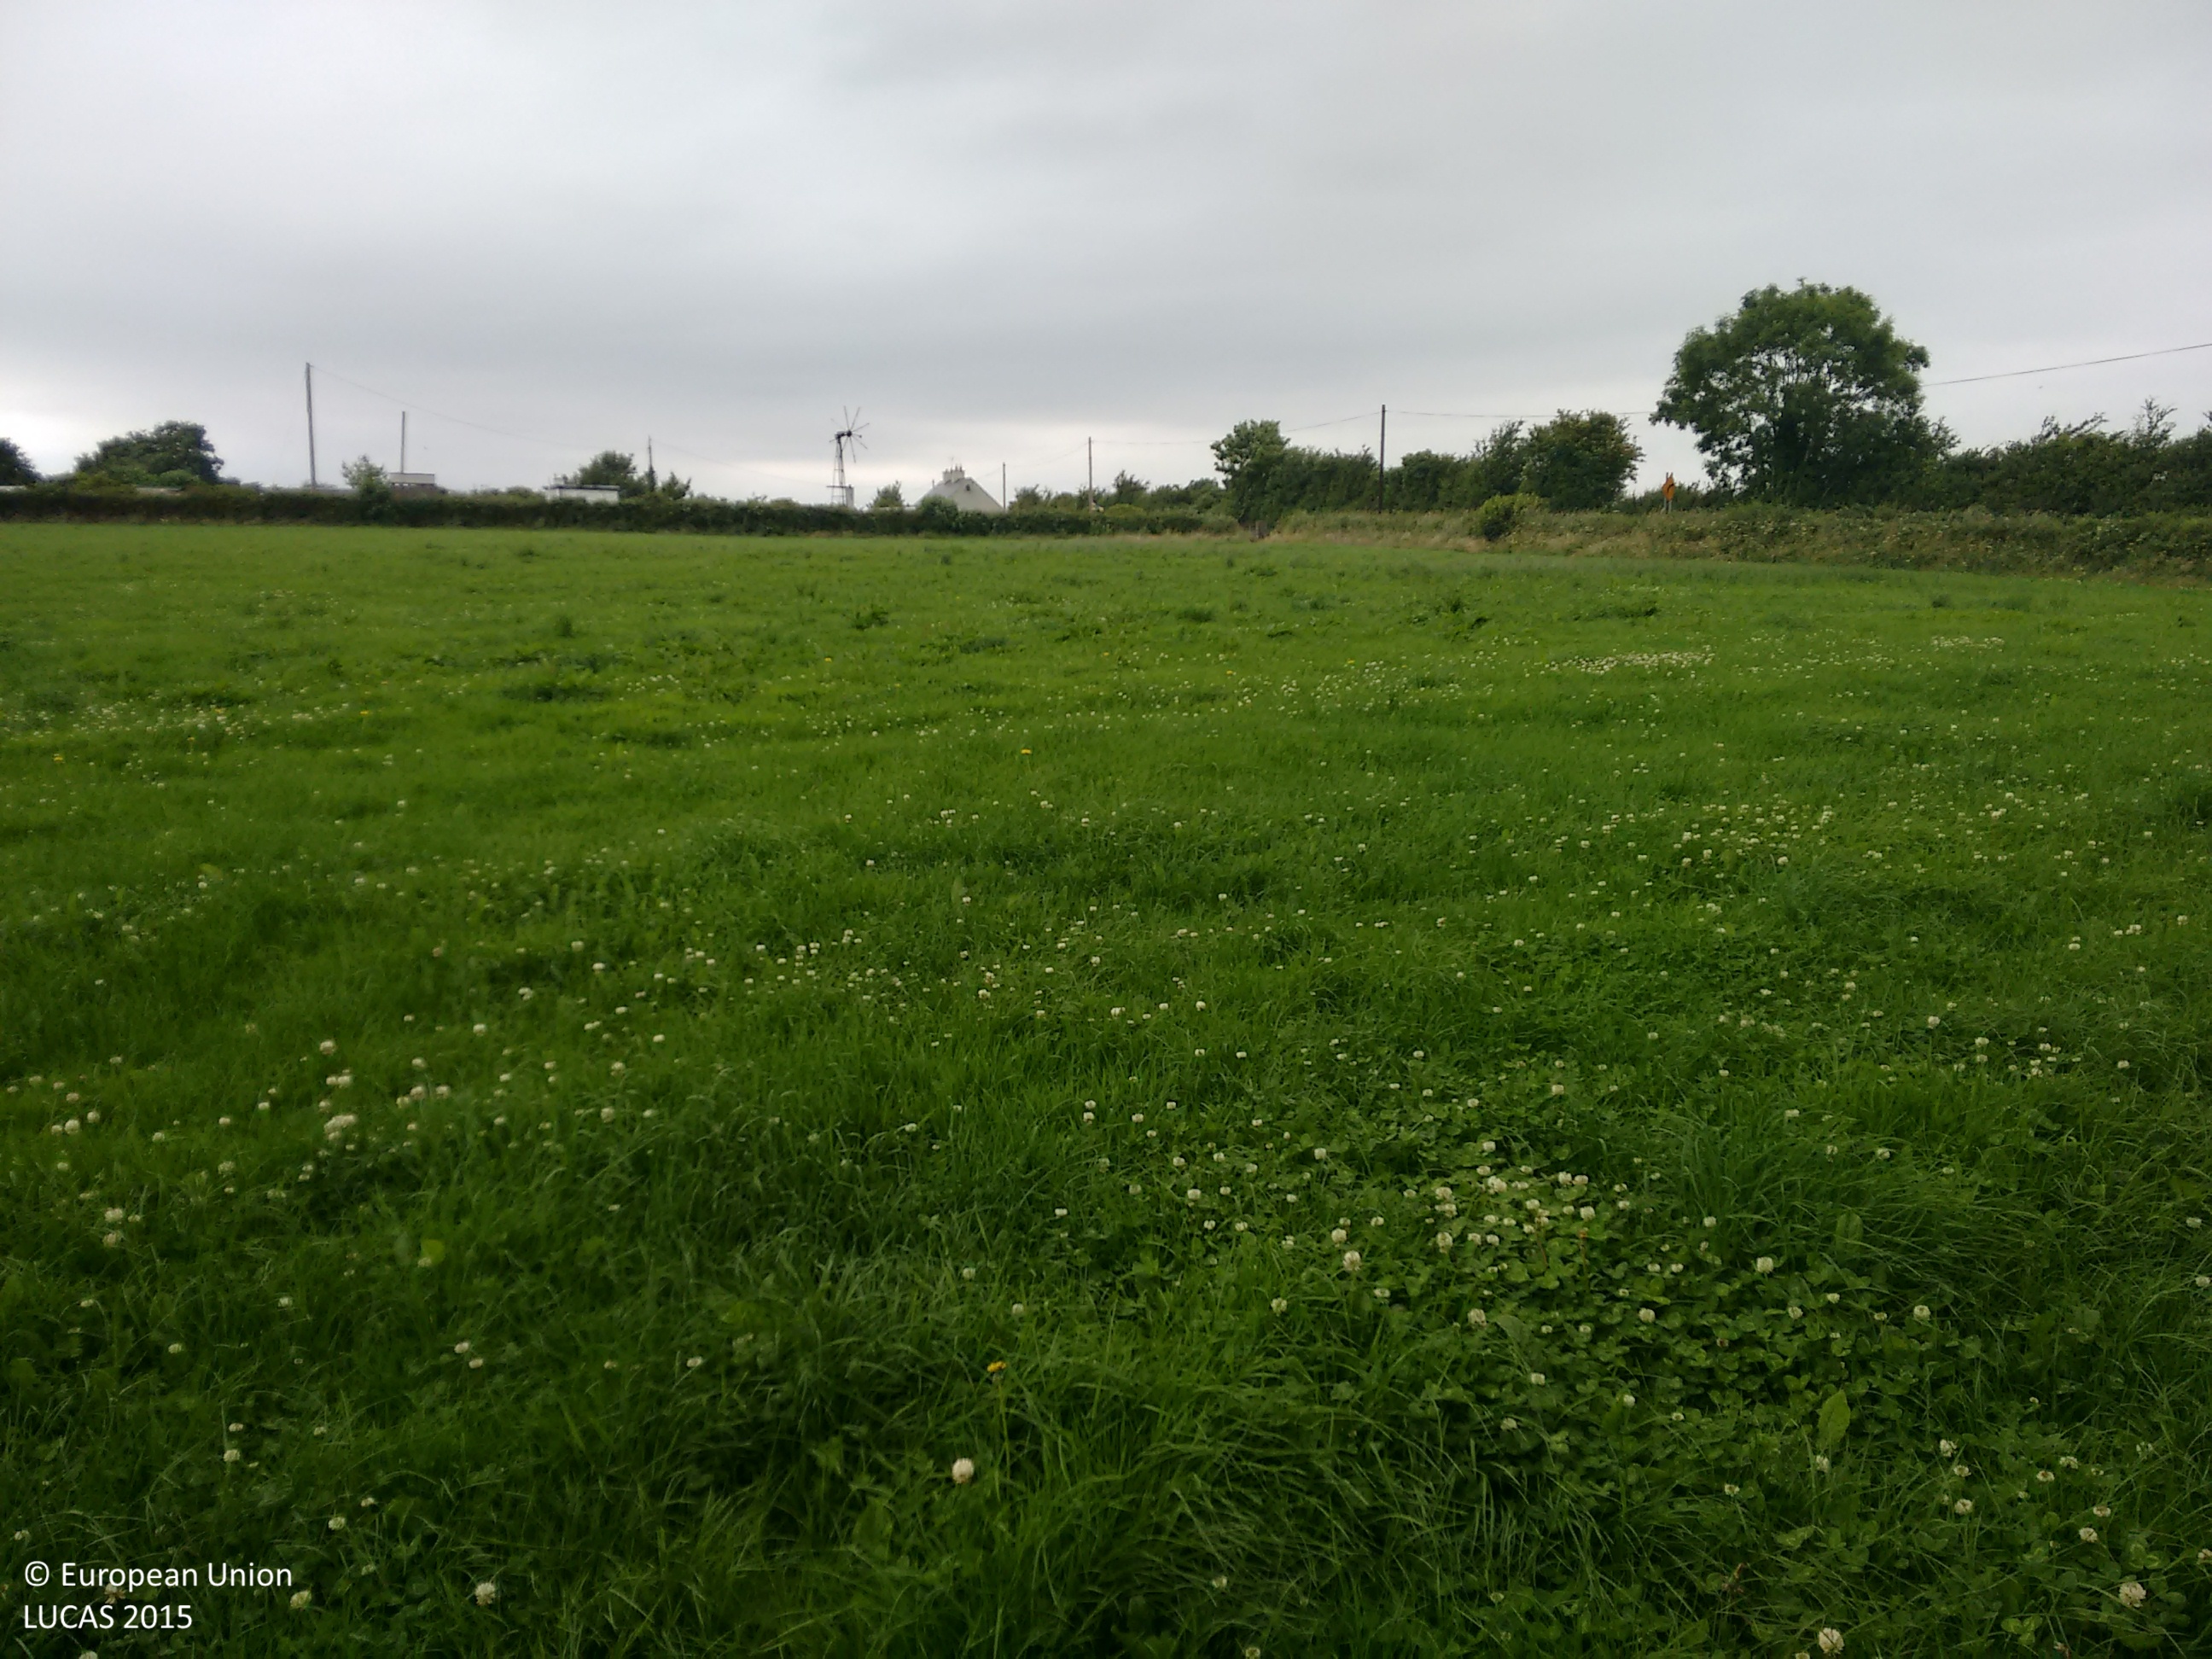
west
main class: Grassland
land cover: Grassland without tree/shrub cover
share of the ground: > 75 %
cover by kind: herbaceous plants 100 %
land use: Agriculture (excluding fallow land and kitchen gardens)
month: July
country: IE
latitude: 52.7213
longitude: -7.4958
